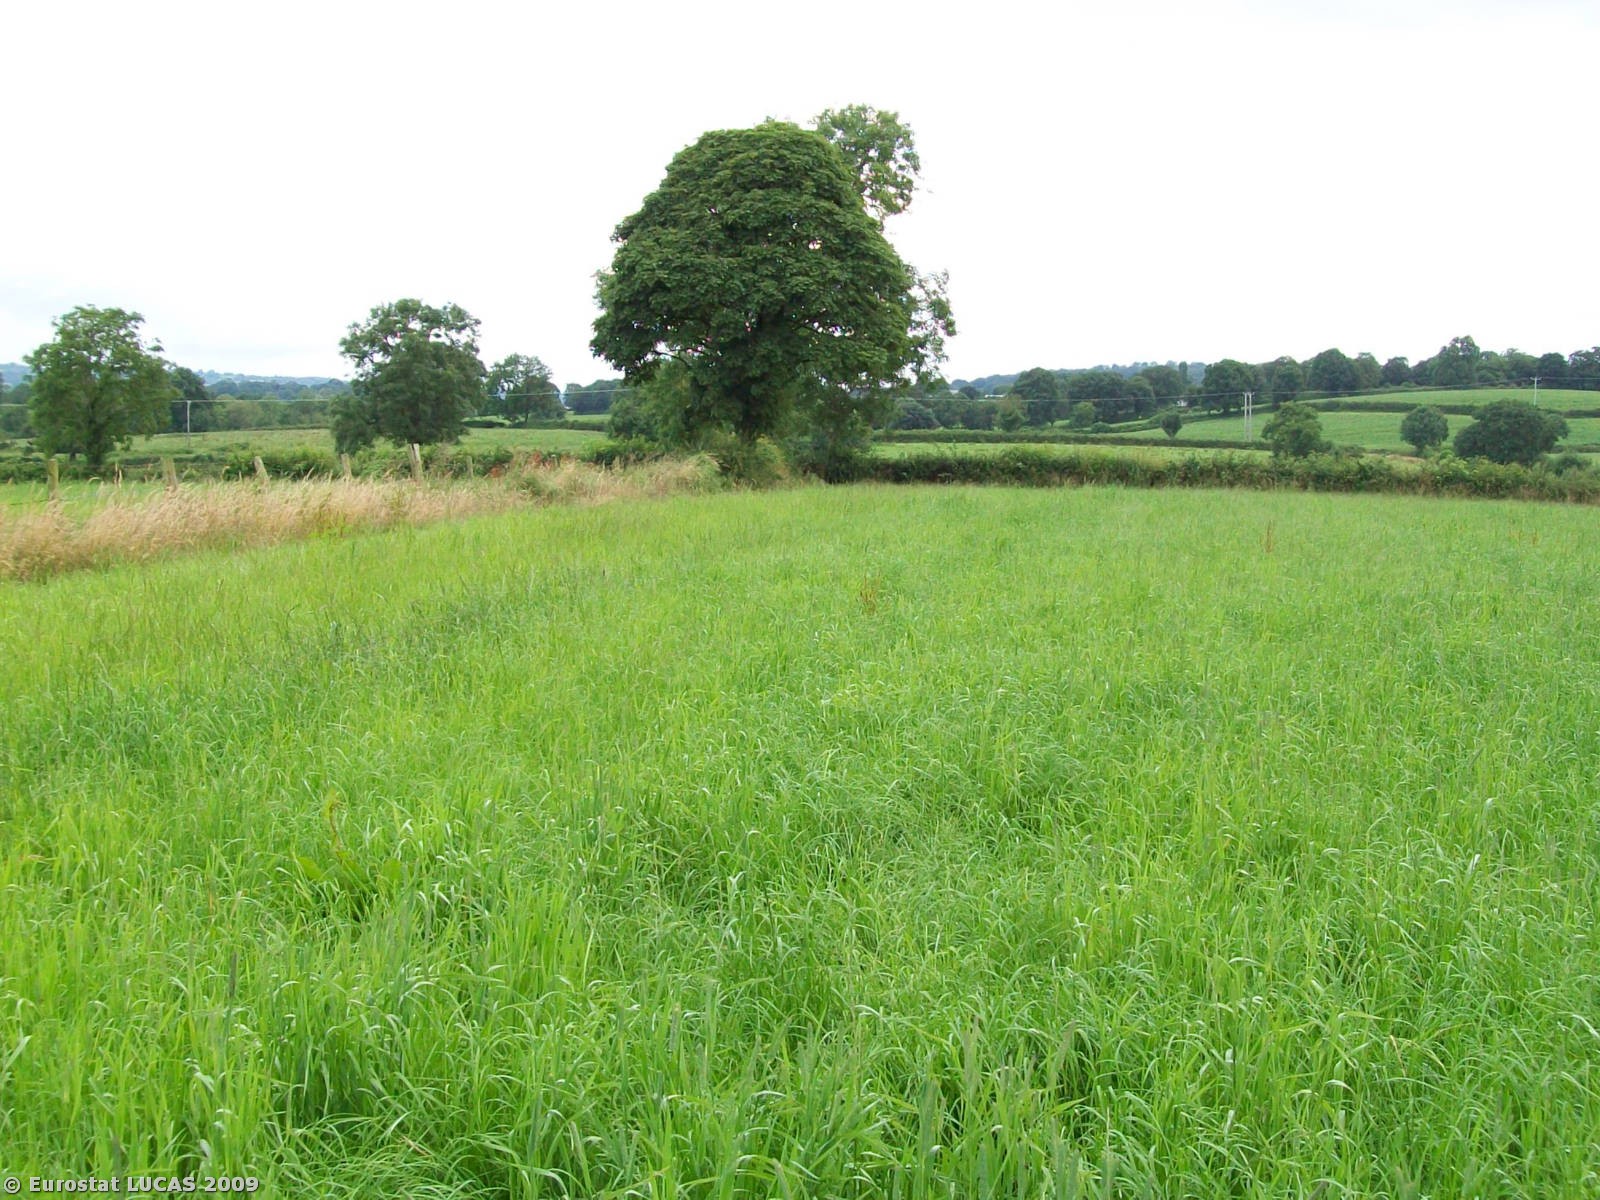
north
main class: Grassland
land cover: Grassland without tree/shrub cover
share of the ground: > 75 %
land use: Agriculture (excluding fallow land and kitchen gardens)
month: July
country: GB
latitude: 54.6621
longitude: -6.6704
